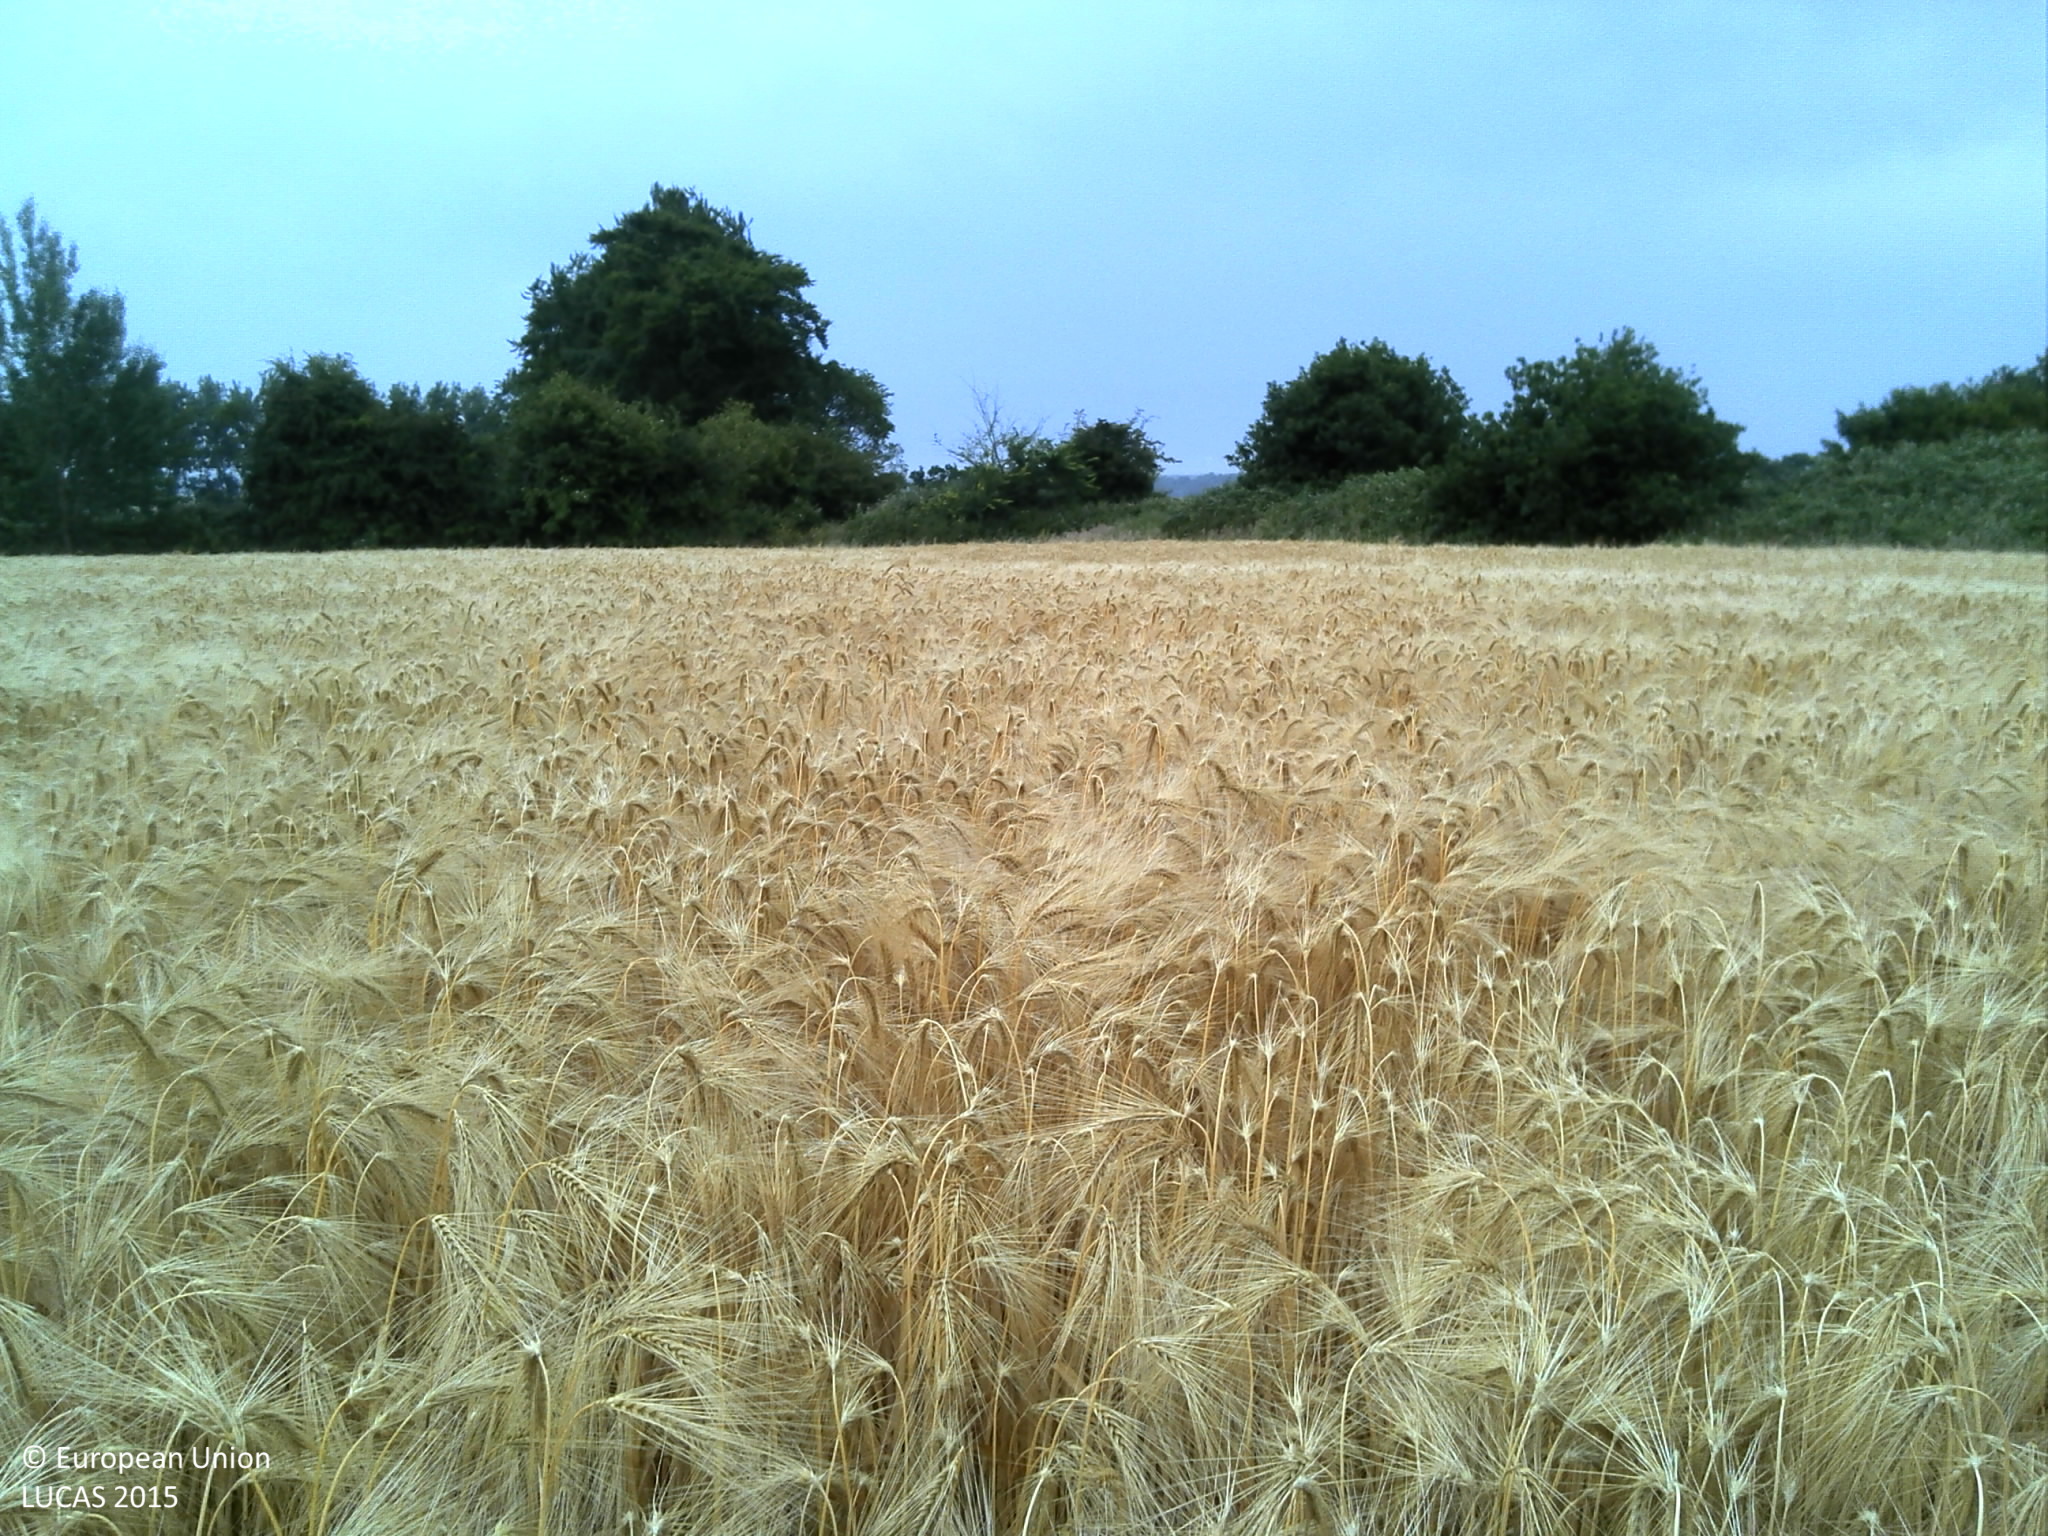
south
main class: Cropland
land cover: Barley
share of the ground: > 75 %
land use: Agriculture (excluding fallow land and kitchen gardens)
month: July
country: FR
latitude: 49.8999
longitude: 0.9975
